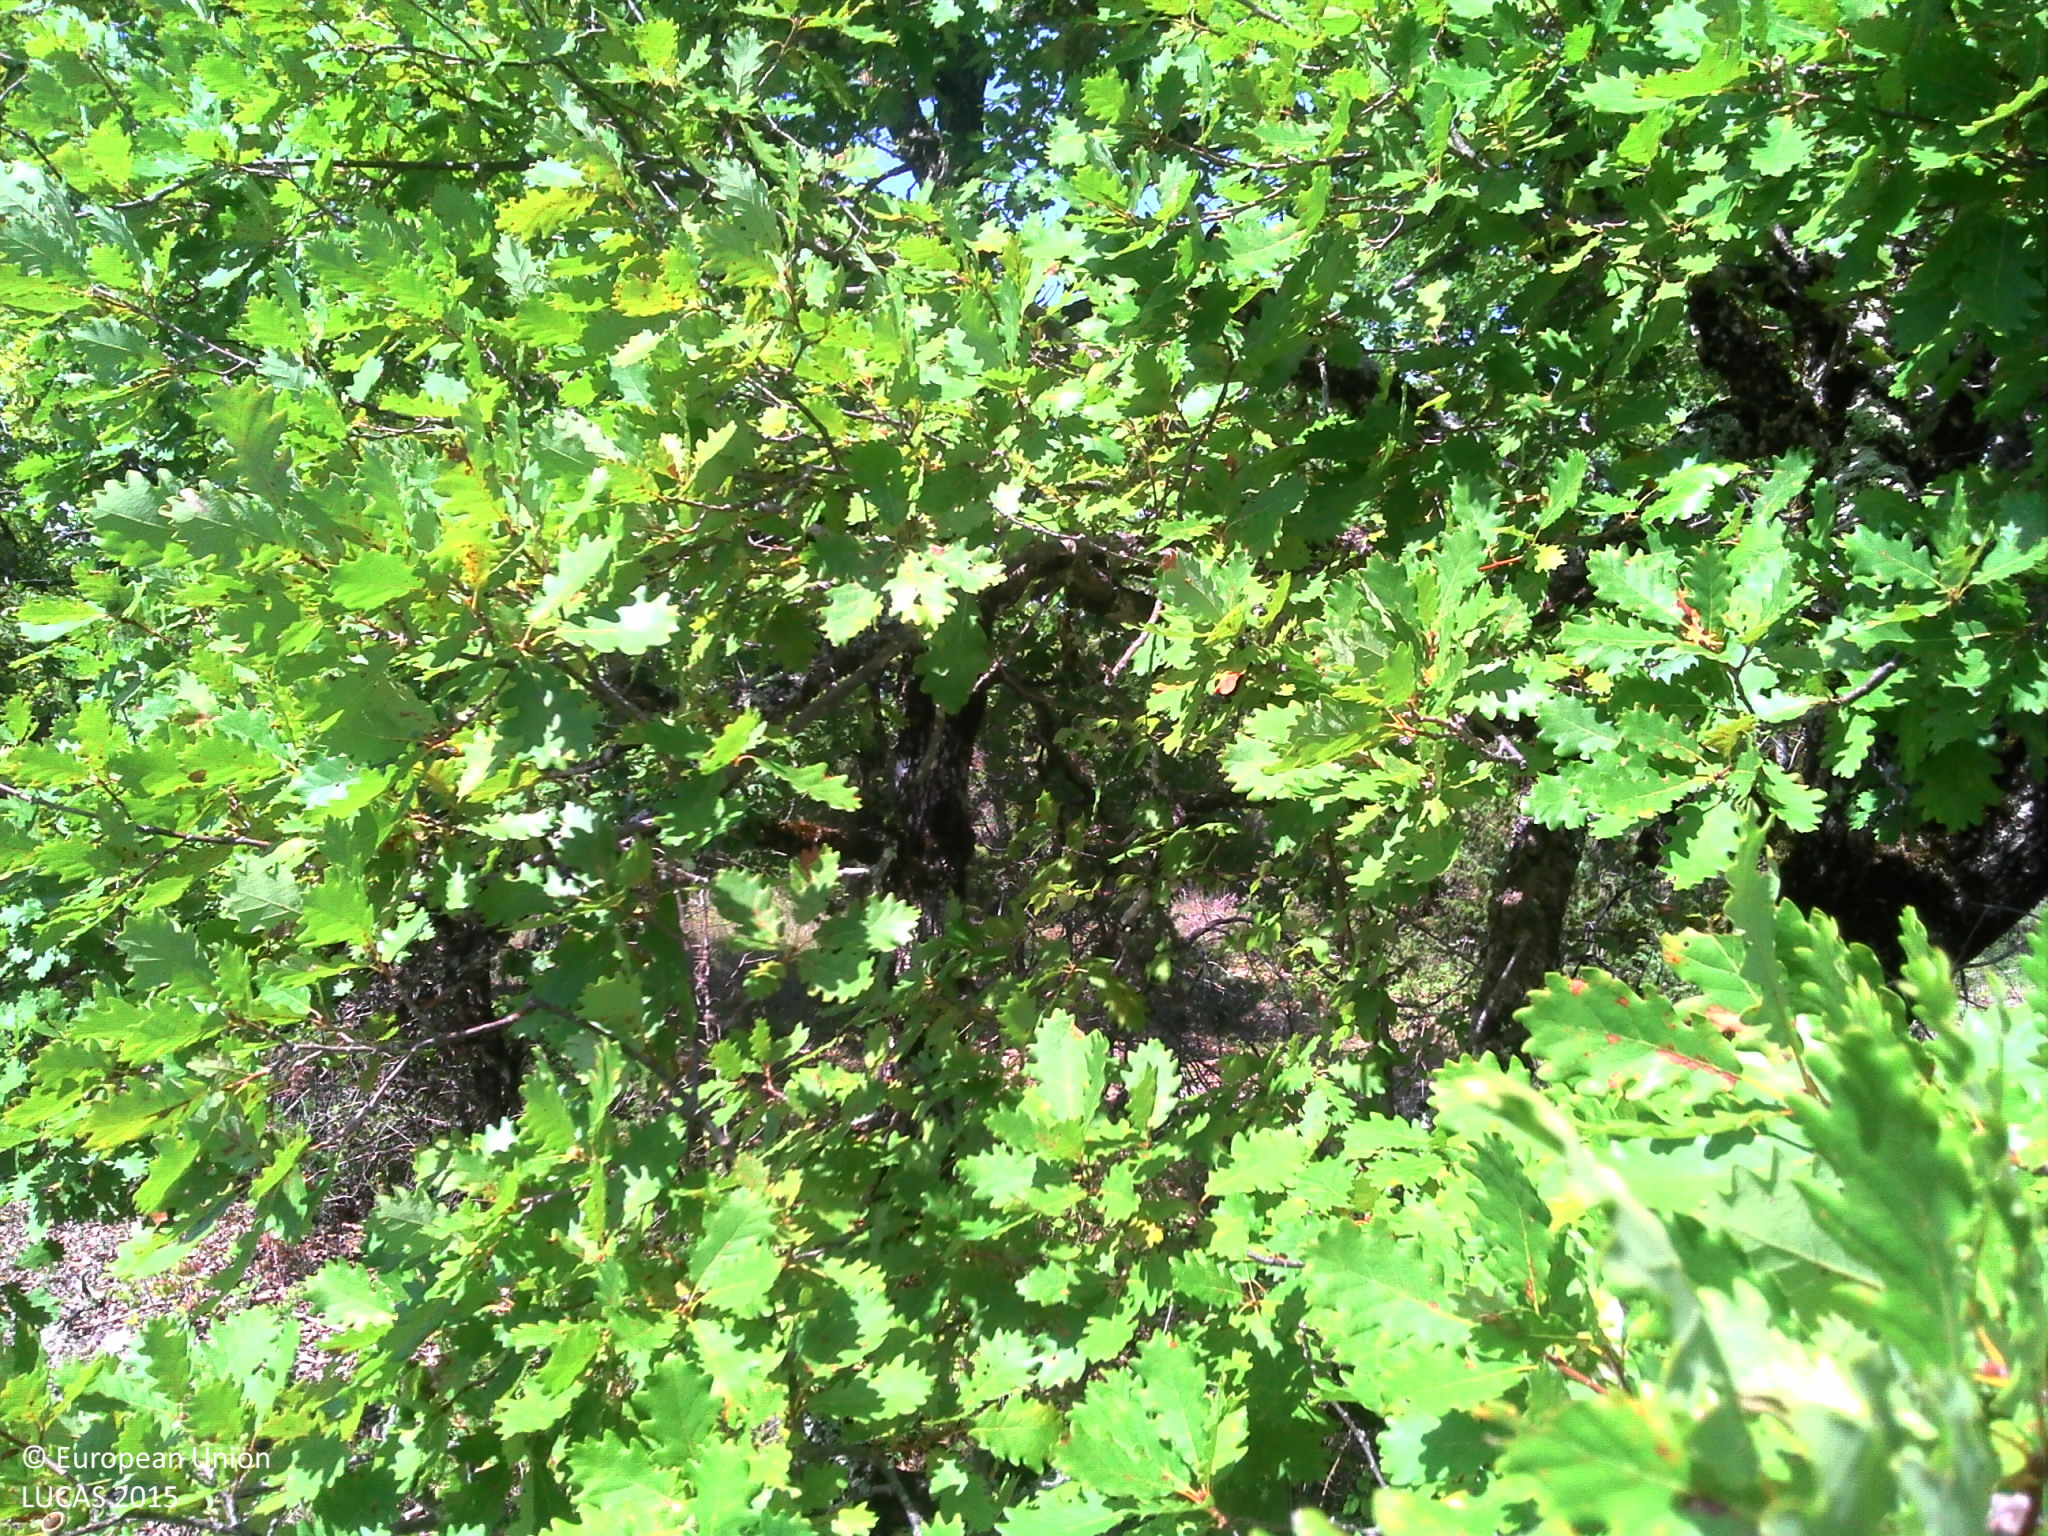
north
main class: Woodland
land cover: Broadleaved woodland
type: thermophilous deciduous forest
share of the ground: > 75 %
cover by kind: broadleaved forest trees 50 %, herbaceous plants 20 %, shrubs 15 %, consolidated bare surface 15 %
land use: Forestry
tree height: > 5 m
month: August
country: FR
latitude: 44.3971
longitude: 1.2466
